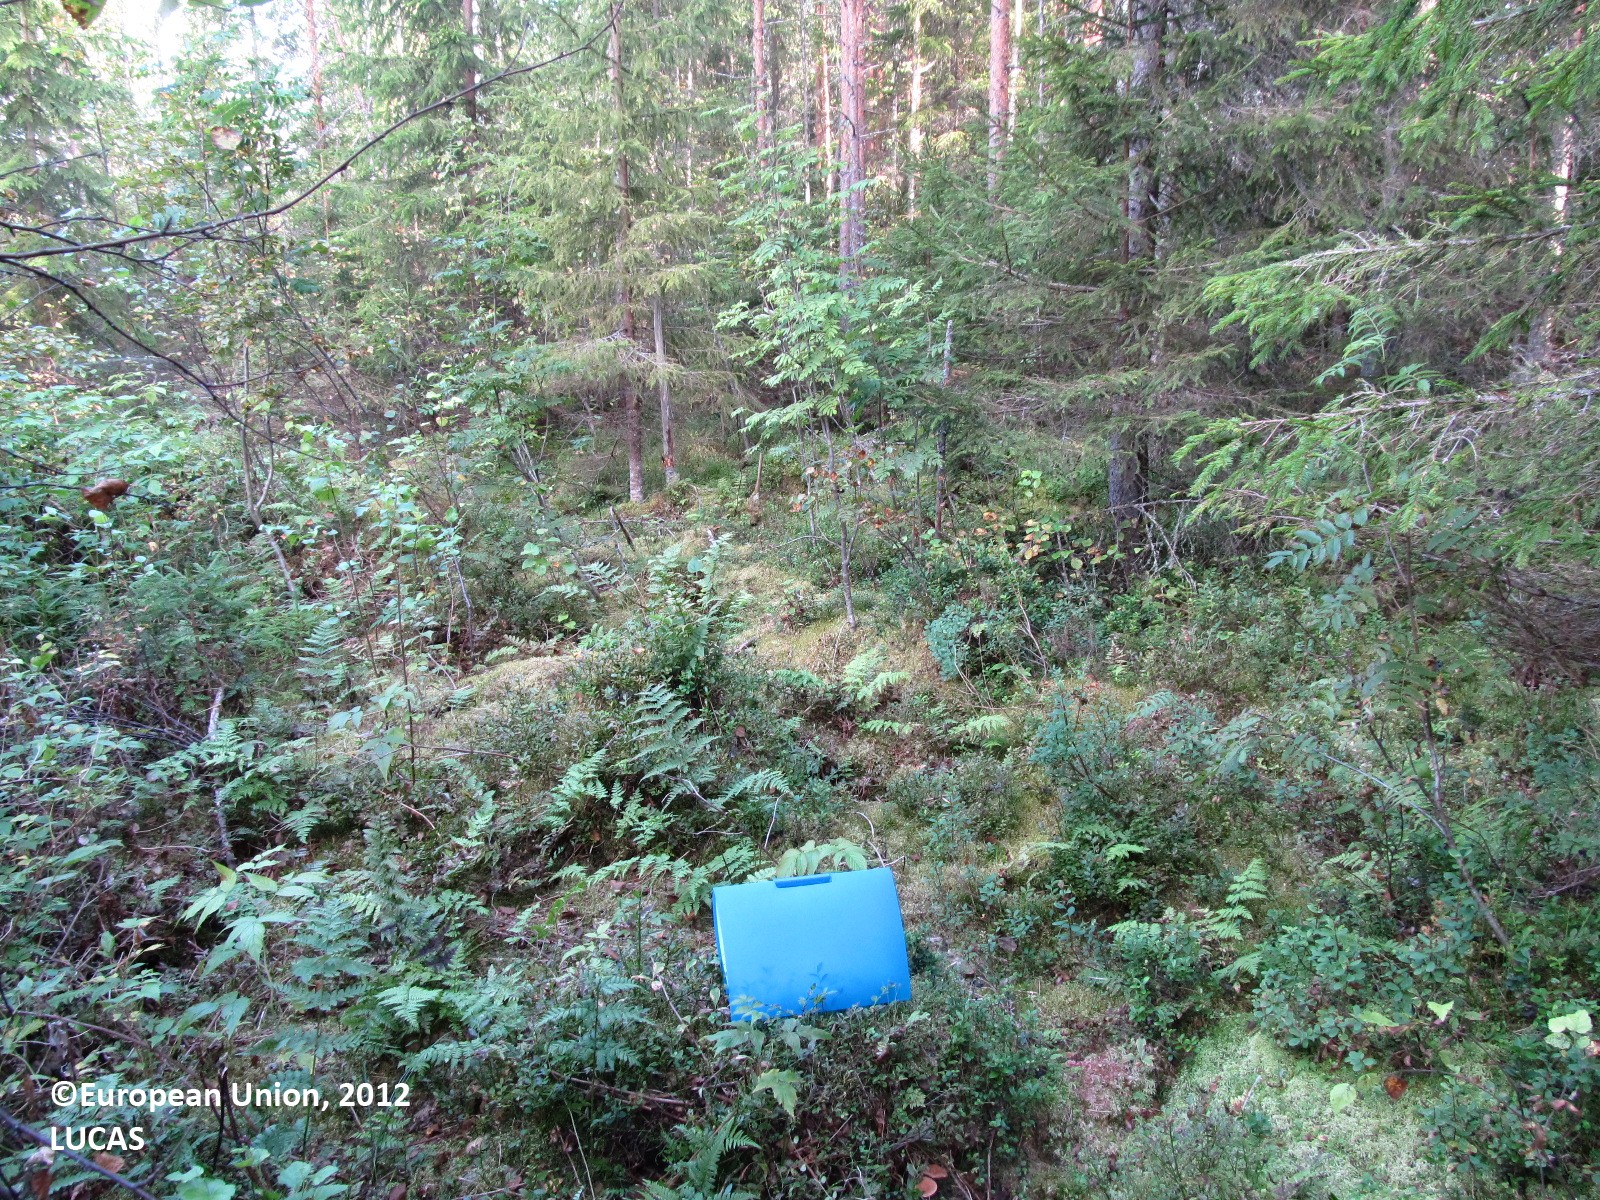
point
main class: Woodland
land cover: Pine dominated mixed woodland
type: boreal forest
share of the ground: 50 - 75 %
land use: Forestry
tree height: > 5 m
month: August
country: FI
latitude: 61.9887
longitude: 27.6022
